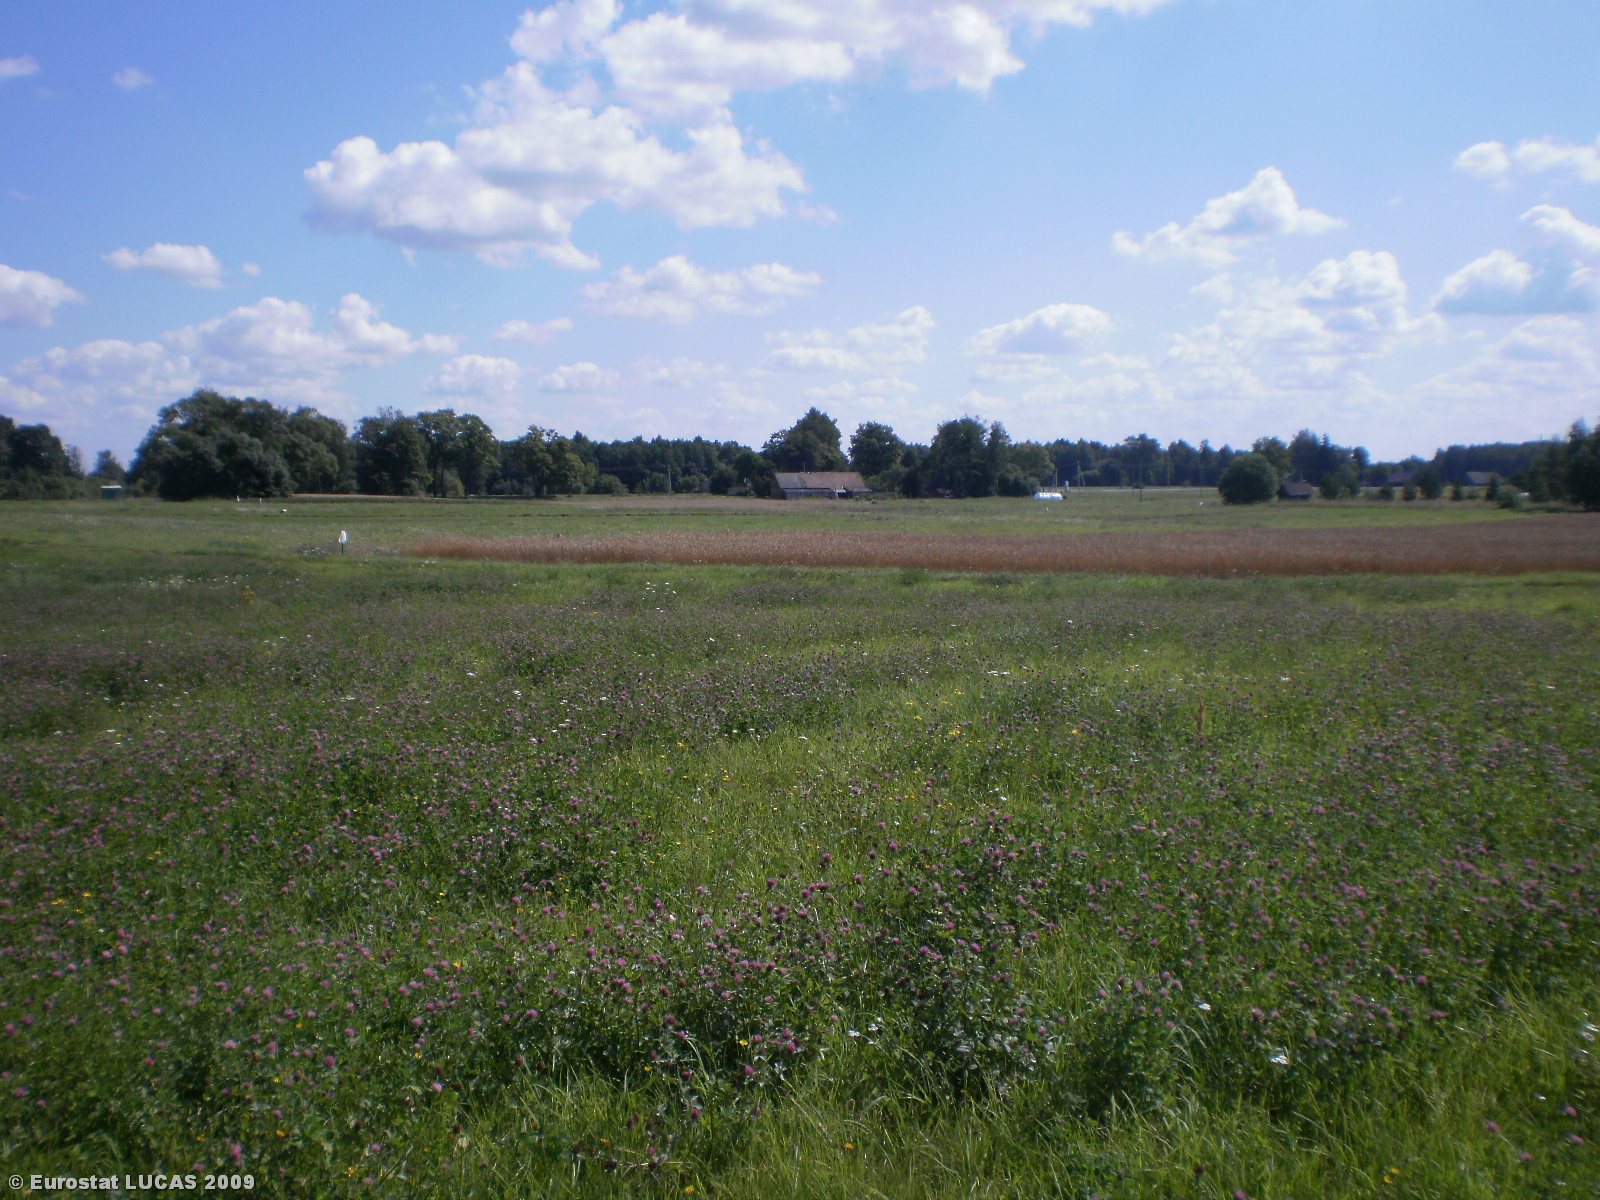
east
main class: Grassland
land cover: Grassland without tree/shrub cover
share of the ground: > 75 %
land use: Agriculture (excluding fallow land and kitchen gardens)
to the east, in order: Grassland without tree/shrub cover; Tracks; Common wheat; Grassland without tree/shrub cover; Tracks; Grassland without tree/shrub cover
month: August
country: LT
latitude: 55.7483
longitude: 25.0720
